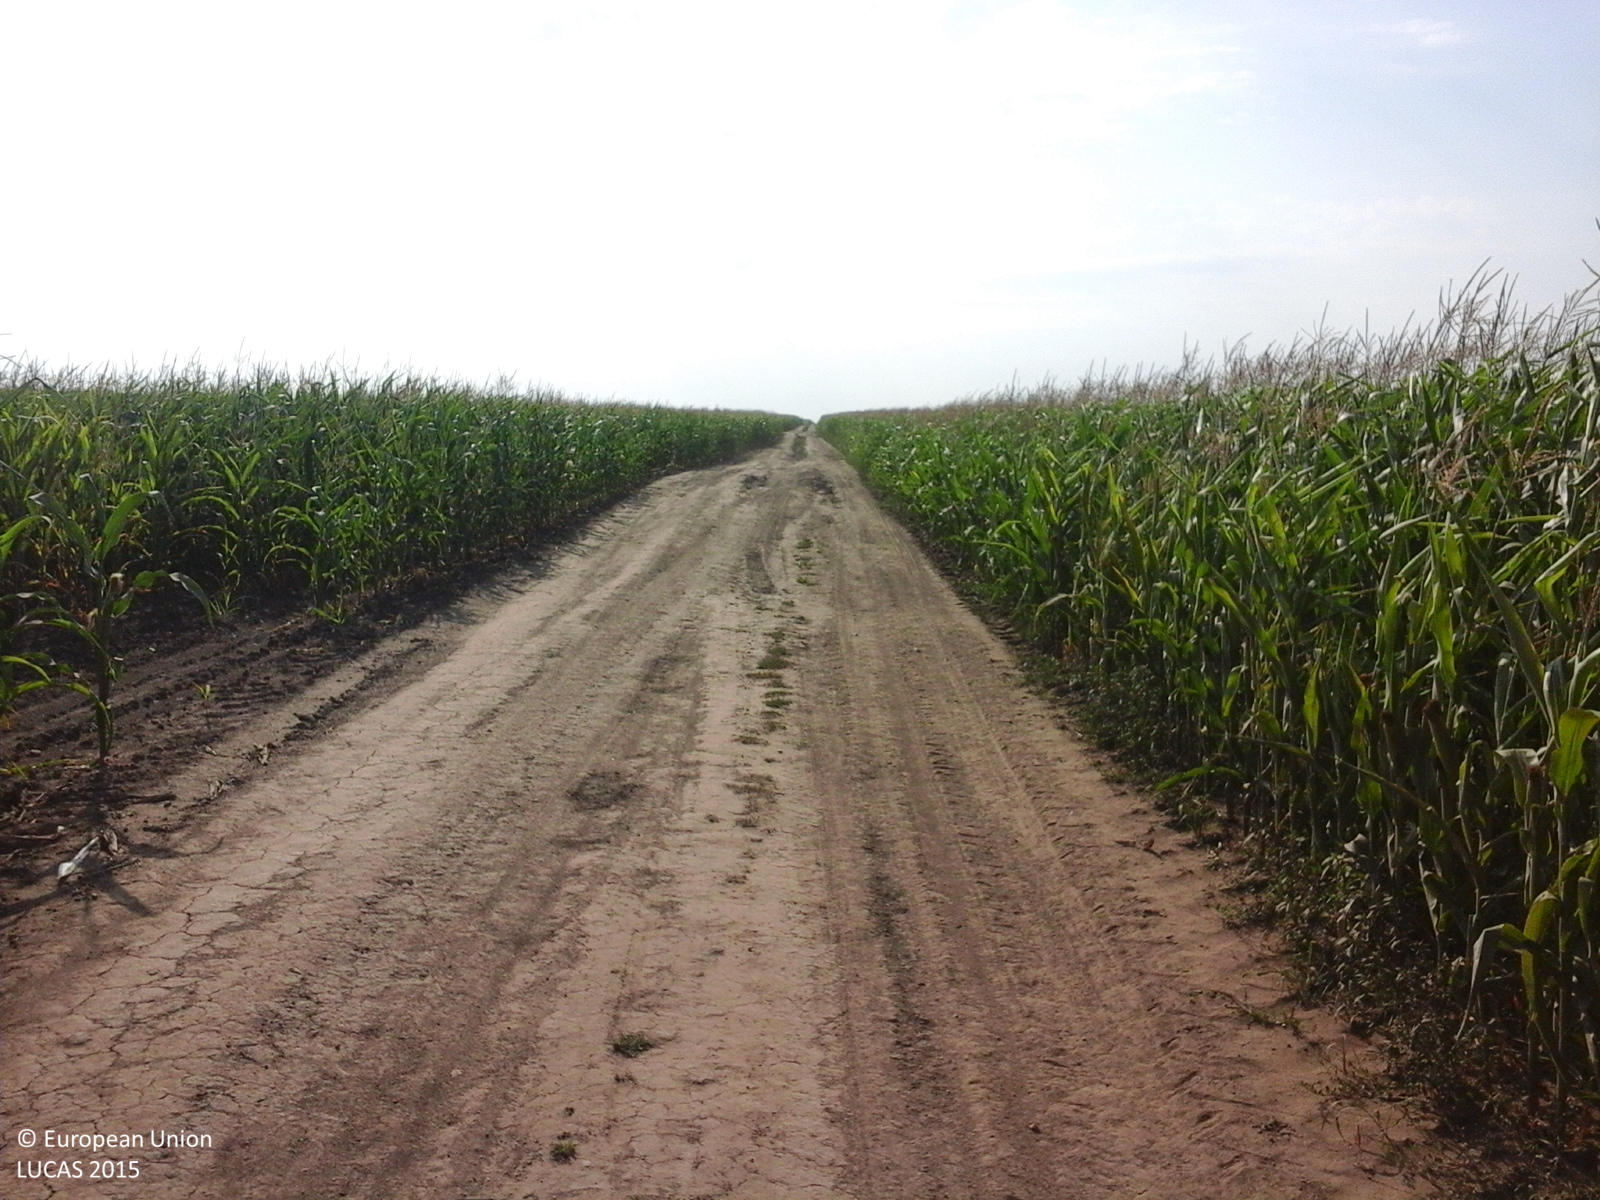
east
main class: Cropland
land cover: Maize
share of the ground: > 75 %
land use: Agriculture (excluding fallow land and kitchen gardens)
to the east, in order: Maize
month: July
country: RO
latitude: 44.6617
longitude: 27.0184
